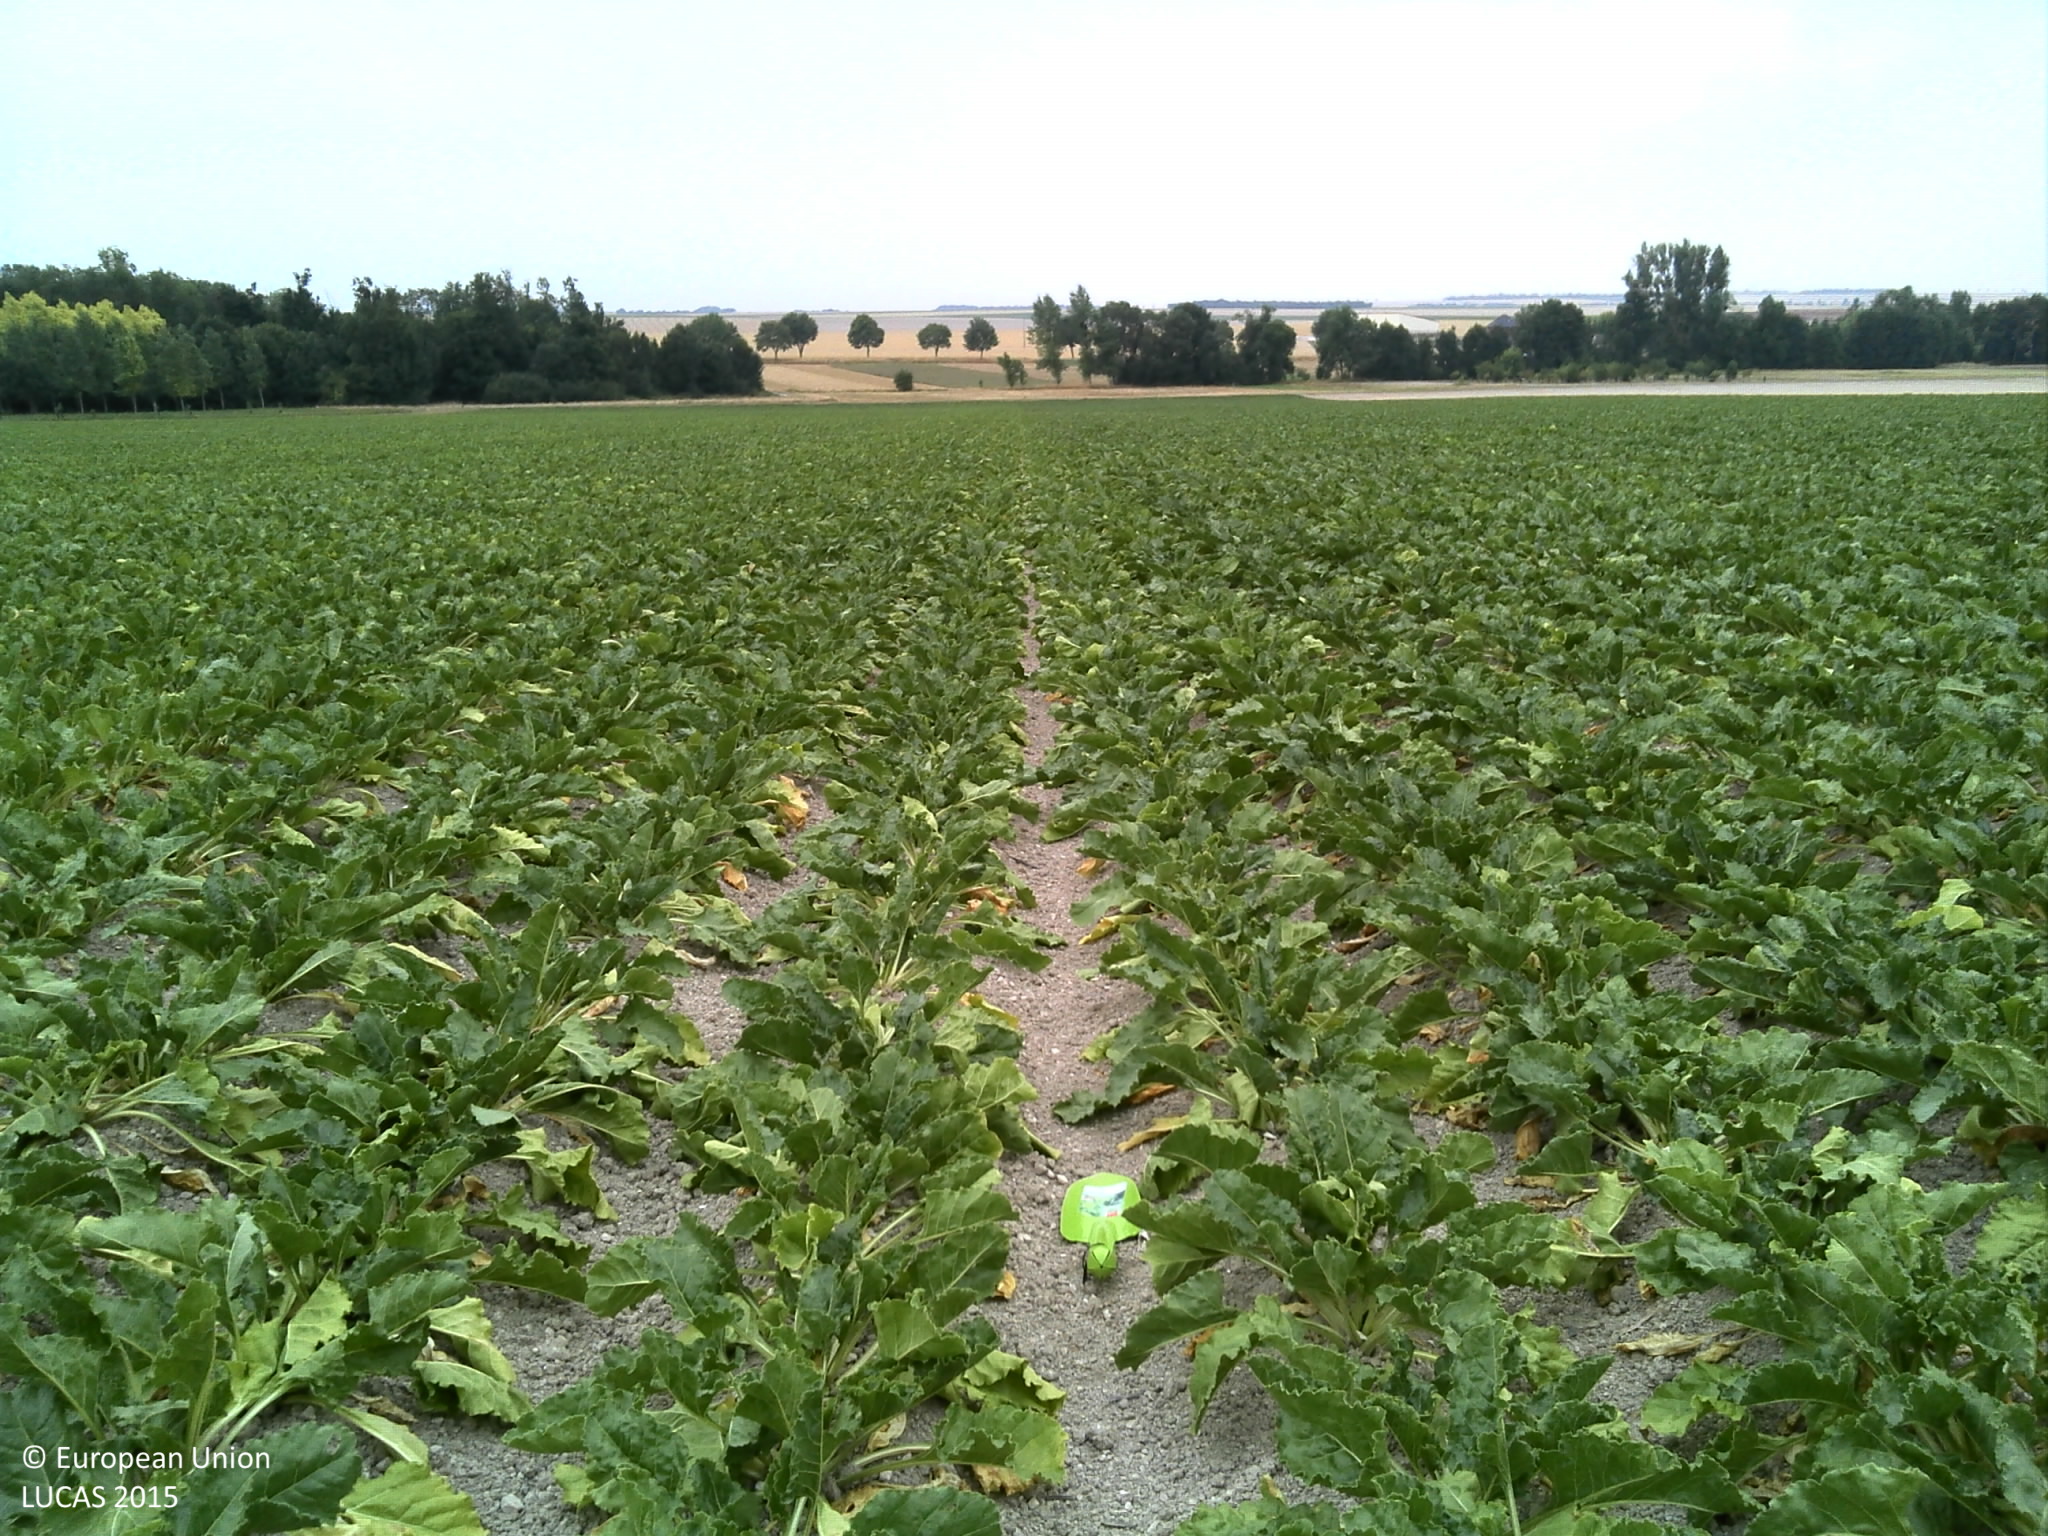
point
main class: Cropland
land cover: Sugar beet
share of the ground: 50 - 75 %
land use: Agriculture (excluding fallow land and kitchen gardens)
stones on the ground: < 10 %
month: August
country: FR
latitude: 48.9378
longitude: 4.2212
